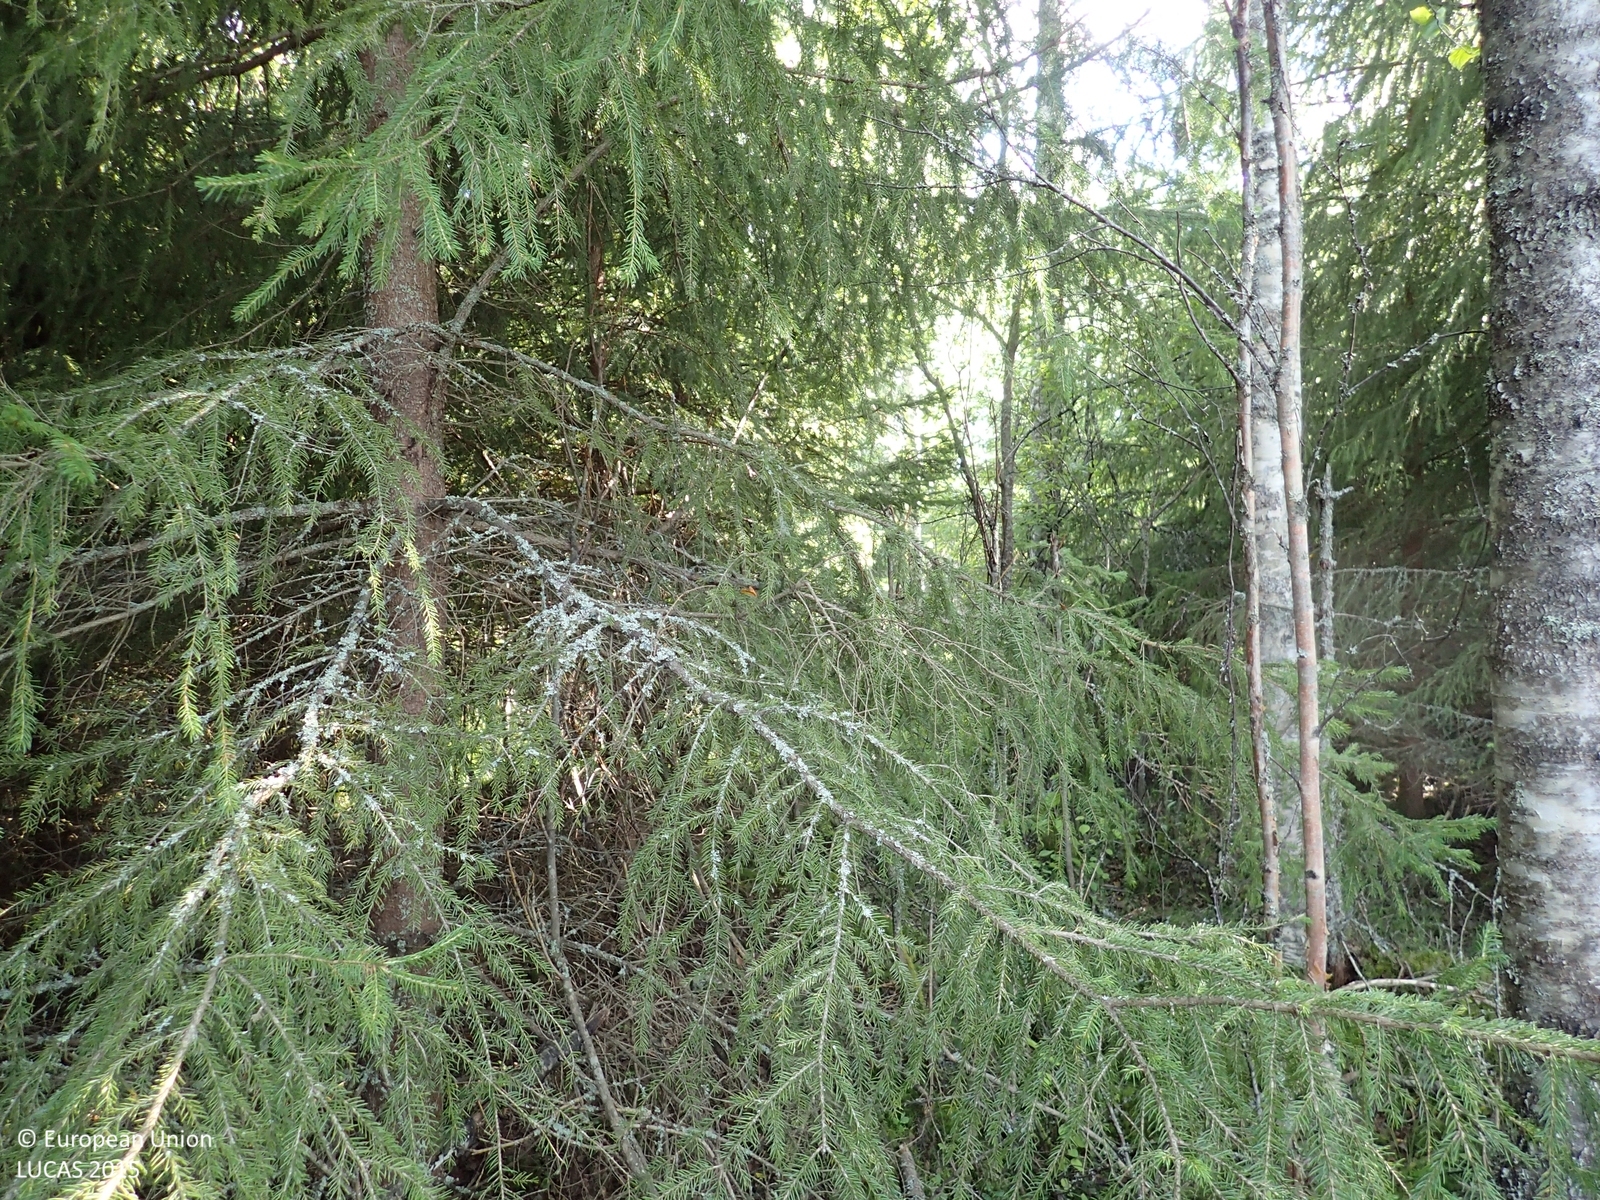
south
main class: Woodland
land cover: Spruce dominated mixed woodland
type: boreal forest
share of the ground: > 75 %
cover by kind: coniferous forest trees 50 %, broadleaved forest trees 30 %, shrubs 10 %, lichens and mosses 10 %
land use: Forestry
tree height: > 5 m
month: August
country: FI
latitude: 62.6450
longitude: 21.9666
